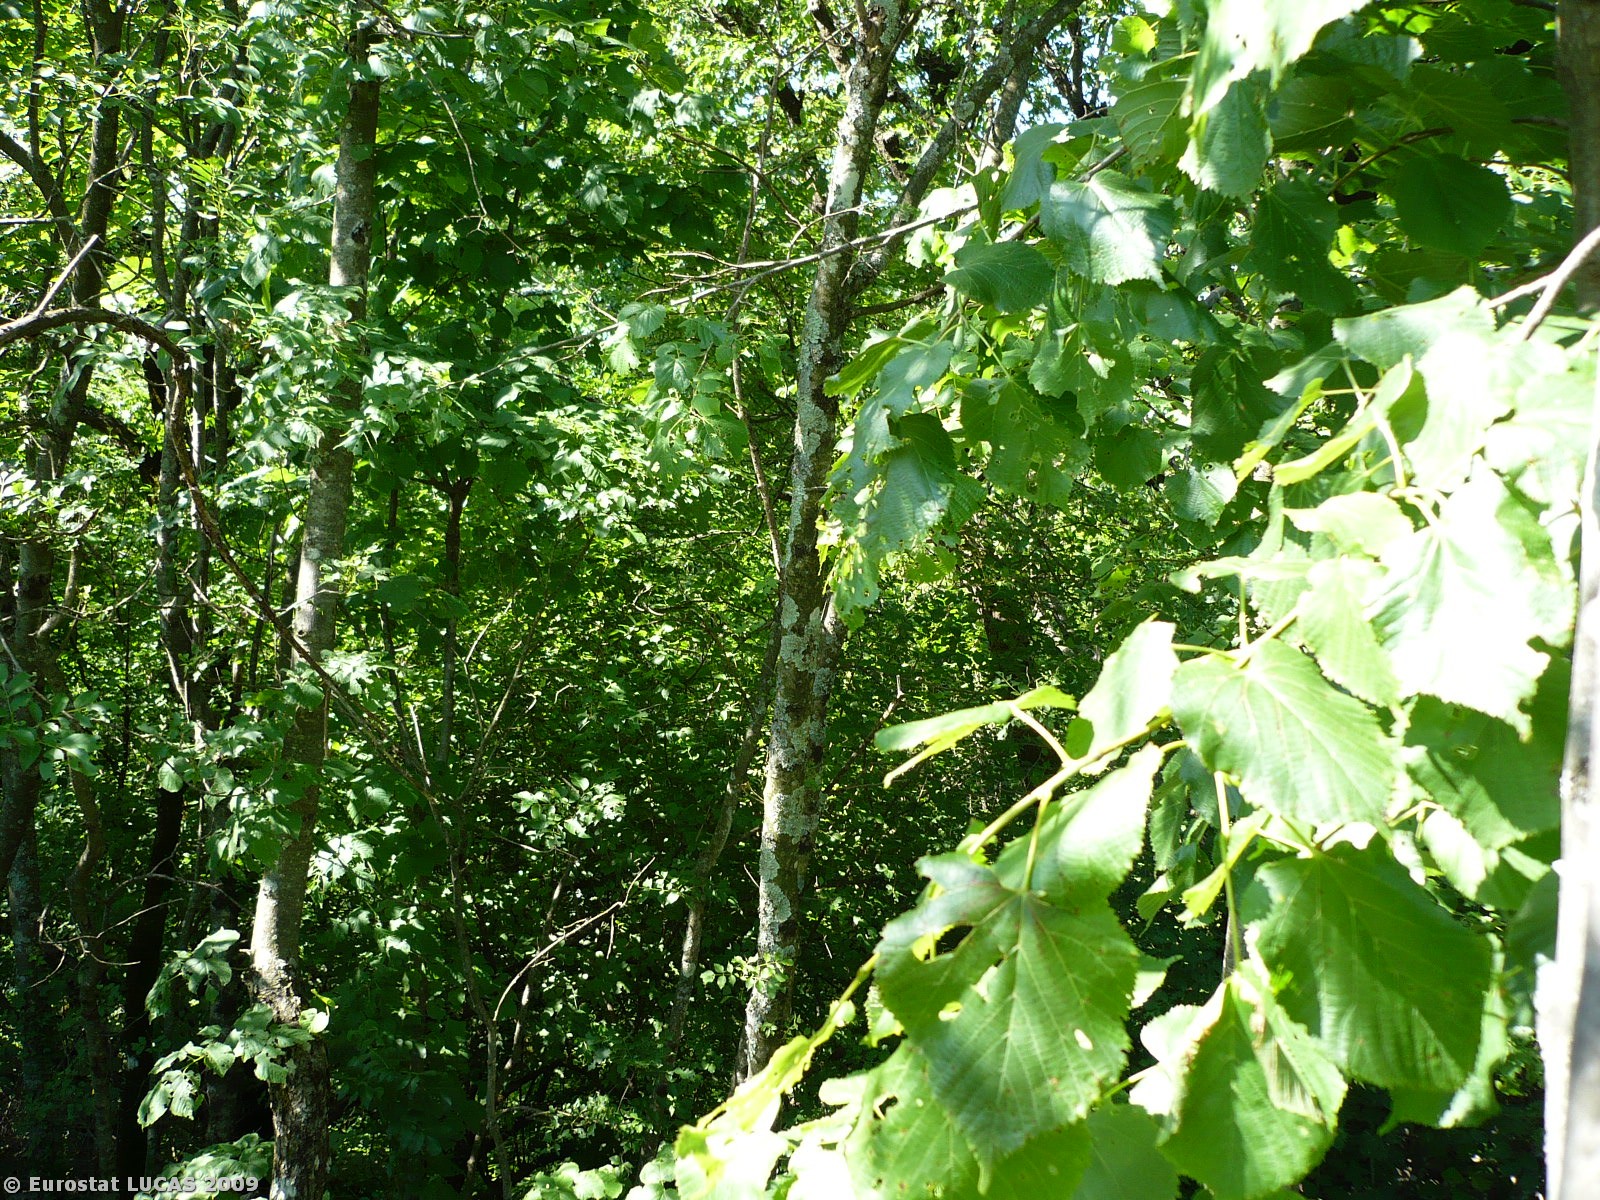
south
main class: Woodland
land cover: Broadleaved woodland
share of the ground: 50 - 75 %
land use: Unused
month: June
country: SI
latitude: 45.8151
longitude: 13.7924
